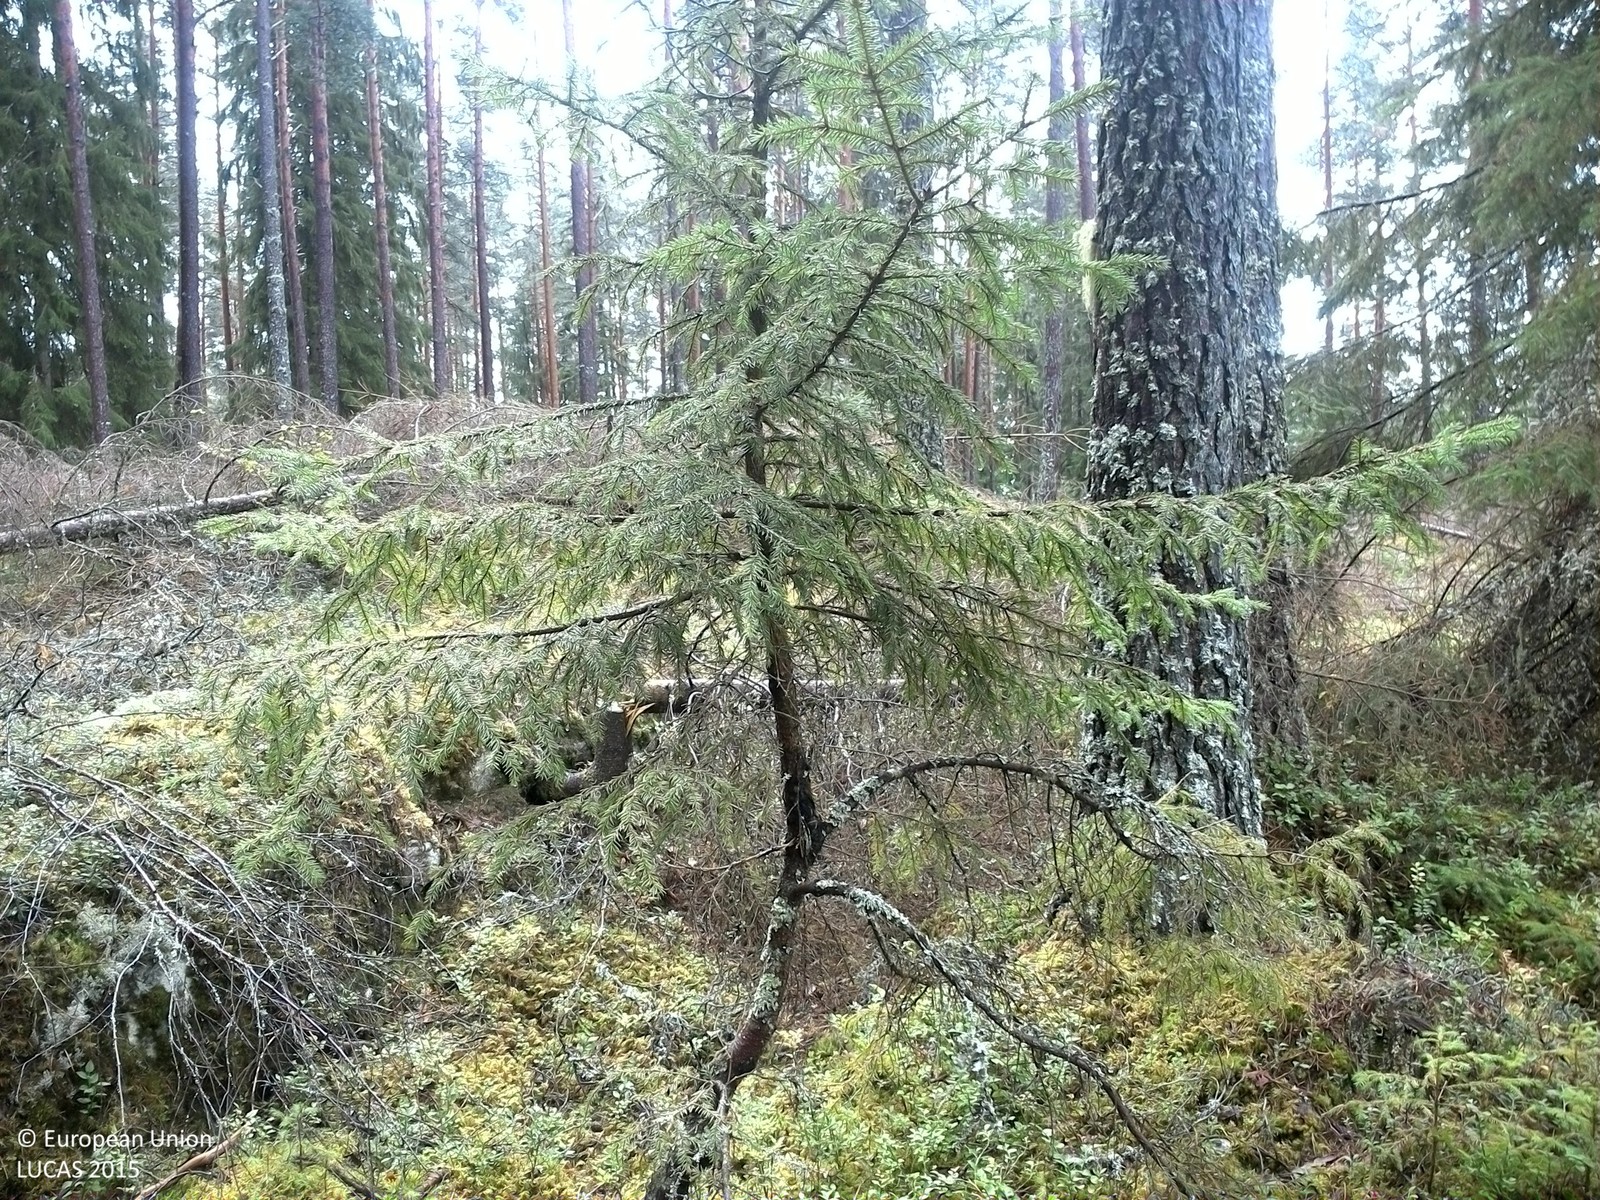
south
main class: Woodland
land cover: Pine dominated coniferous woodland
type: boreal forest
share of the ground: 50 - 75 %
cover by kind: coniferous forest trees 65 %, lichens and mosses 20 %, shrubs 10 %, broadleaved forest trees 5 %
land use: Forestry
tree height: > 5 m
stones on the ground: < 10 %
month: September
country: SE
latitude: 59.2656
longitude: 12.0474
